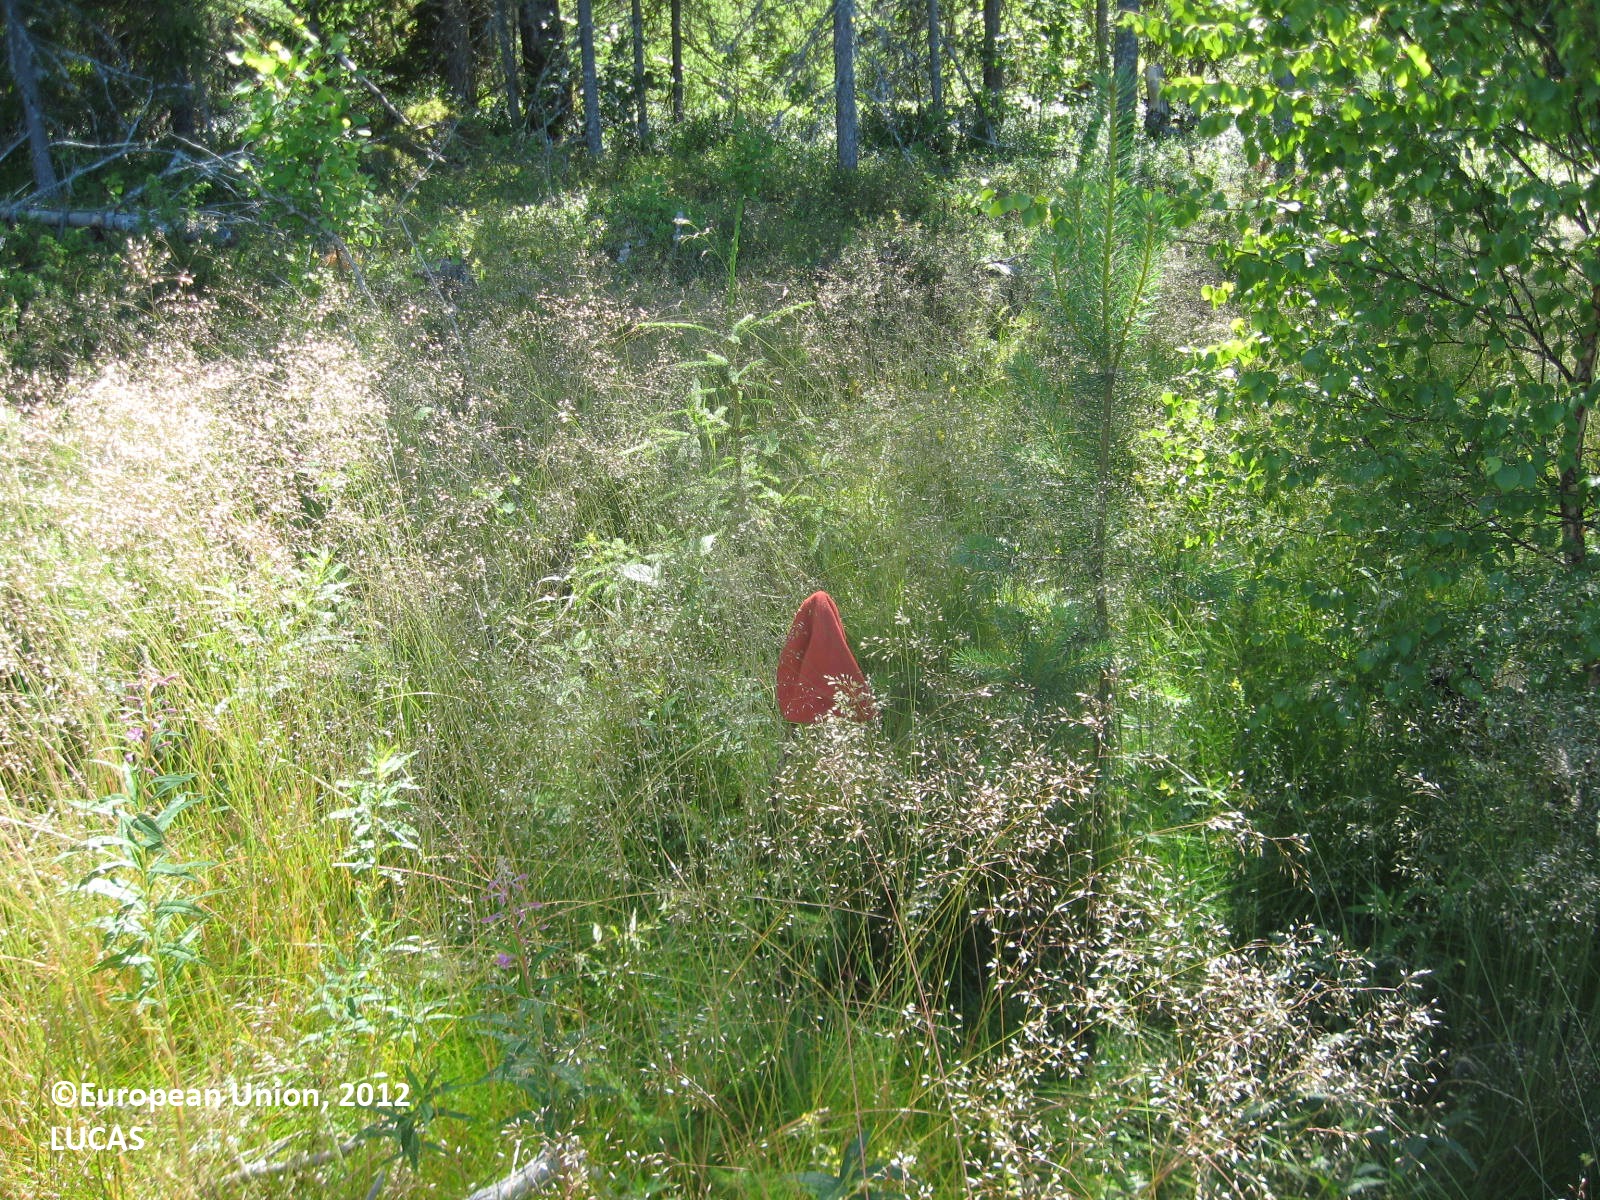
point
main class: Woodland
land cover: Other mixed woodland
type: boreal forest
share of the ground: 10 - 25 %
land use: Forestry
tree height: < 5 m
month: July
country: FI
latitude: 62.0987
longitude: 21.4821
